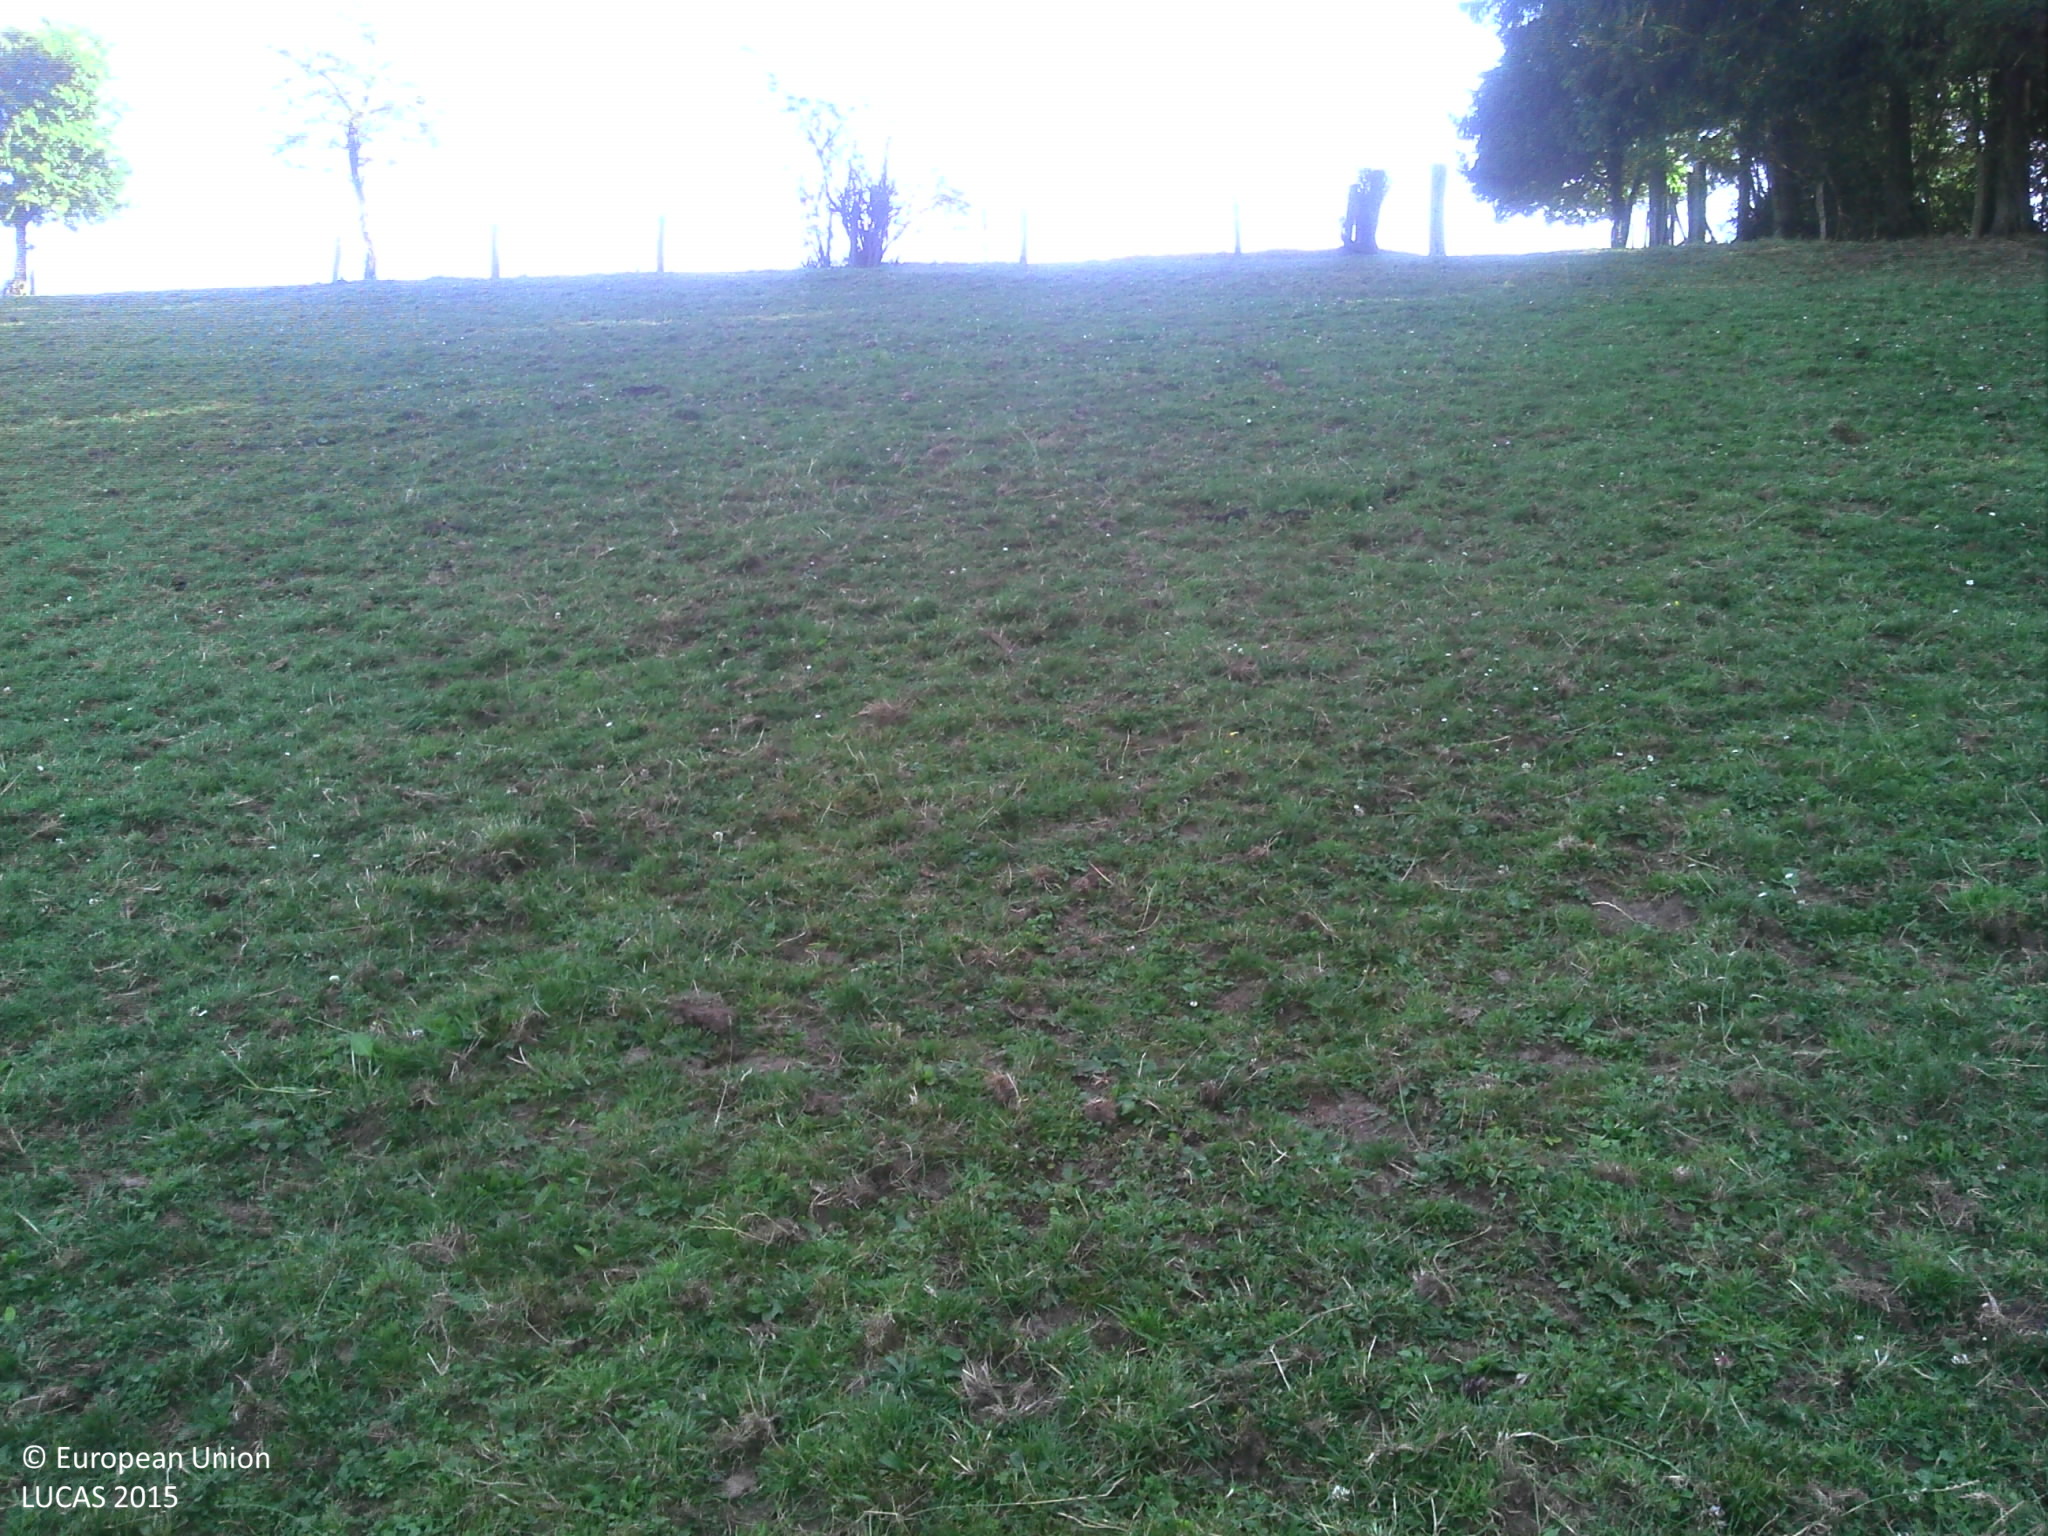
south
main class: Grassland
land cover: Grassland without tree/shrub cover
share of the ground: > 75 %
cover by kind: herbaceous plants 100 %
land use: Agriculture (excluding fallow land and kitchen gardens)
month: July
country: BE
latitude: 49.8501
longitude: 5.6734
